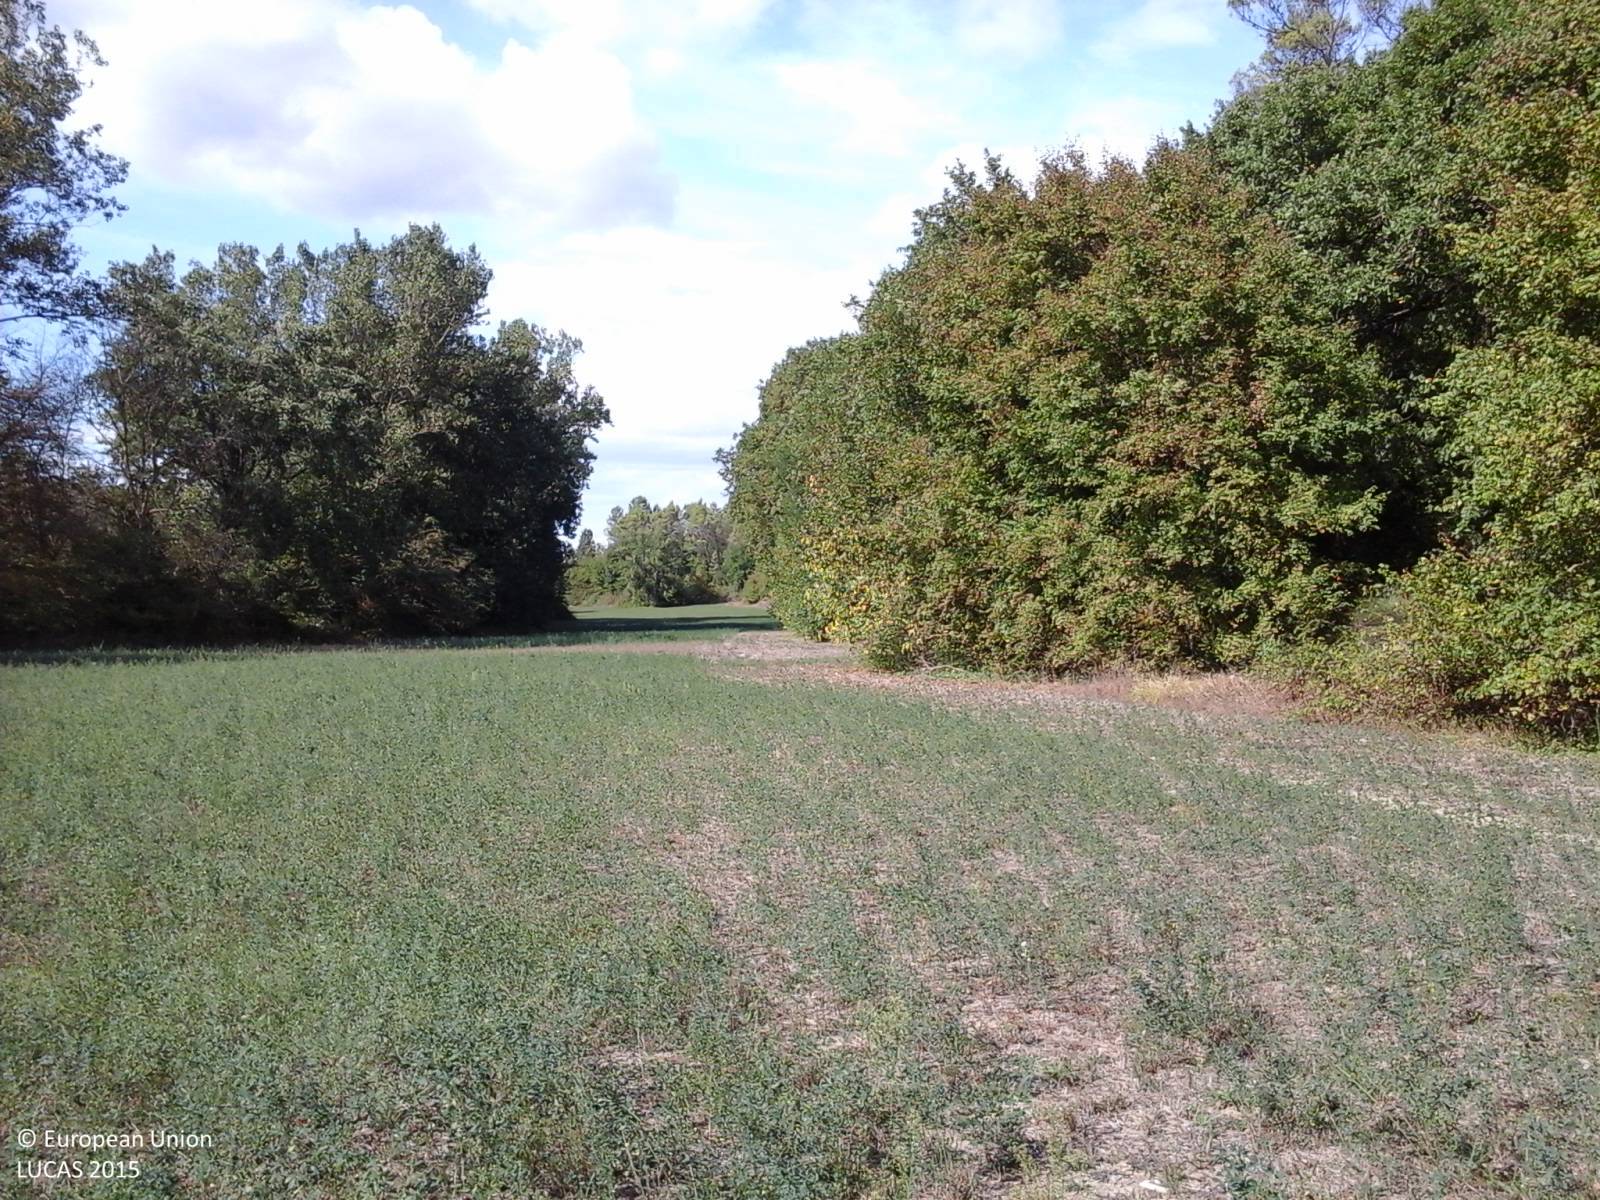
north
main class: Cropland
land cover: Lucerne
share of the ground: > 75 %
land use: Agriculture (excluding fallow land and kitchen gardens)
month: September
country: IT
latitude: 42.9284
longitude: 12.5776
